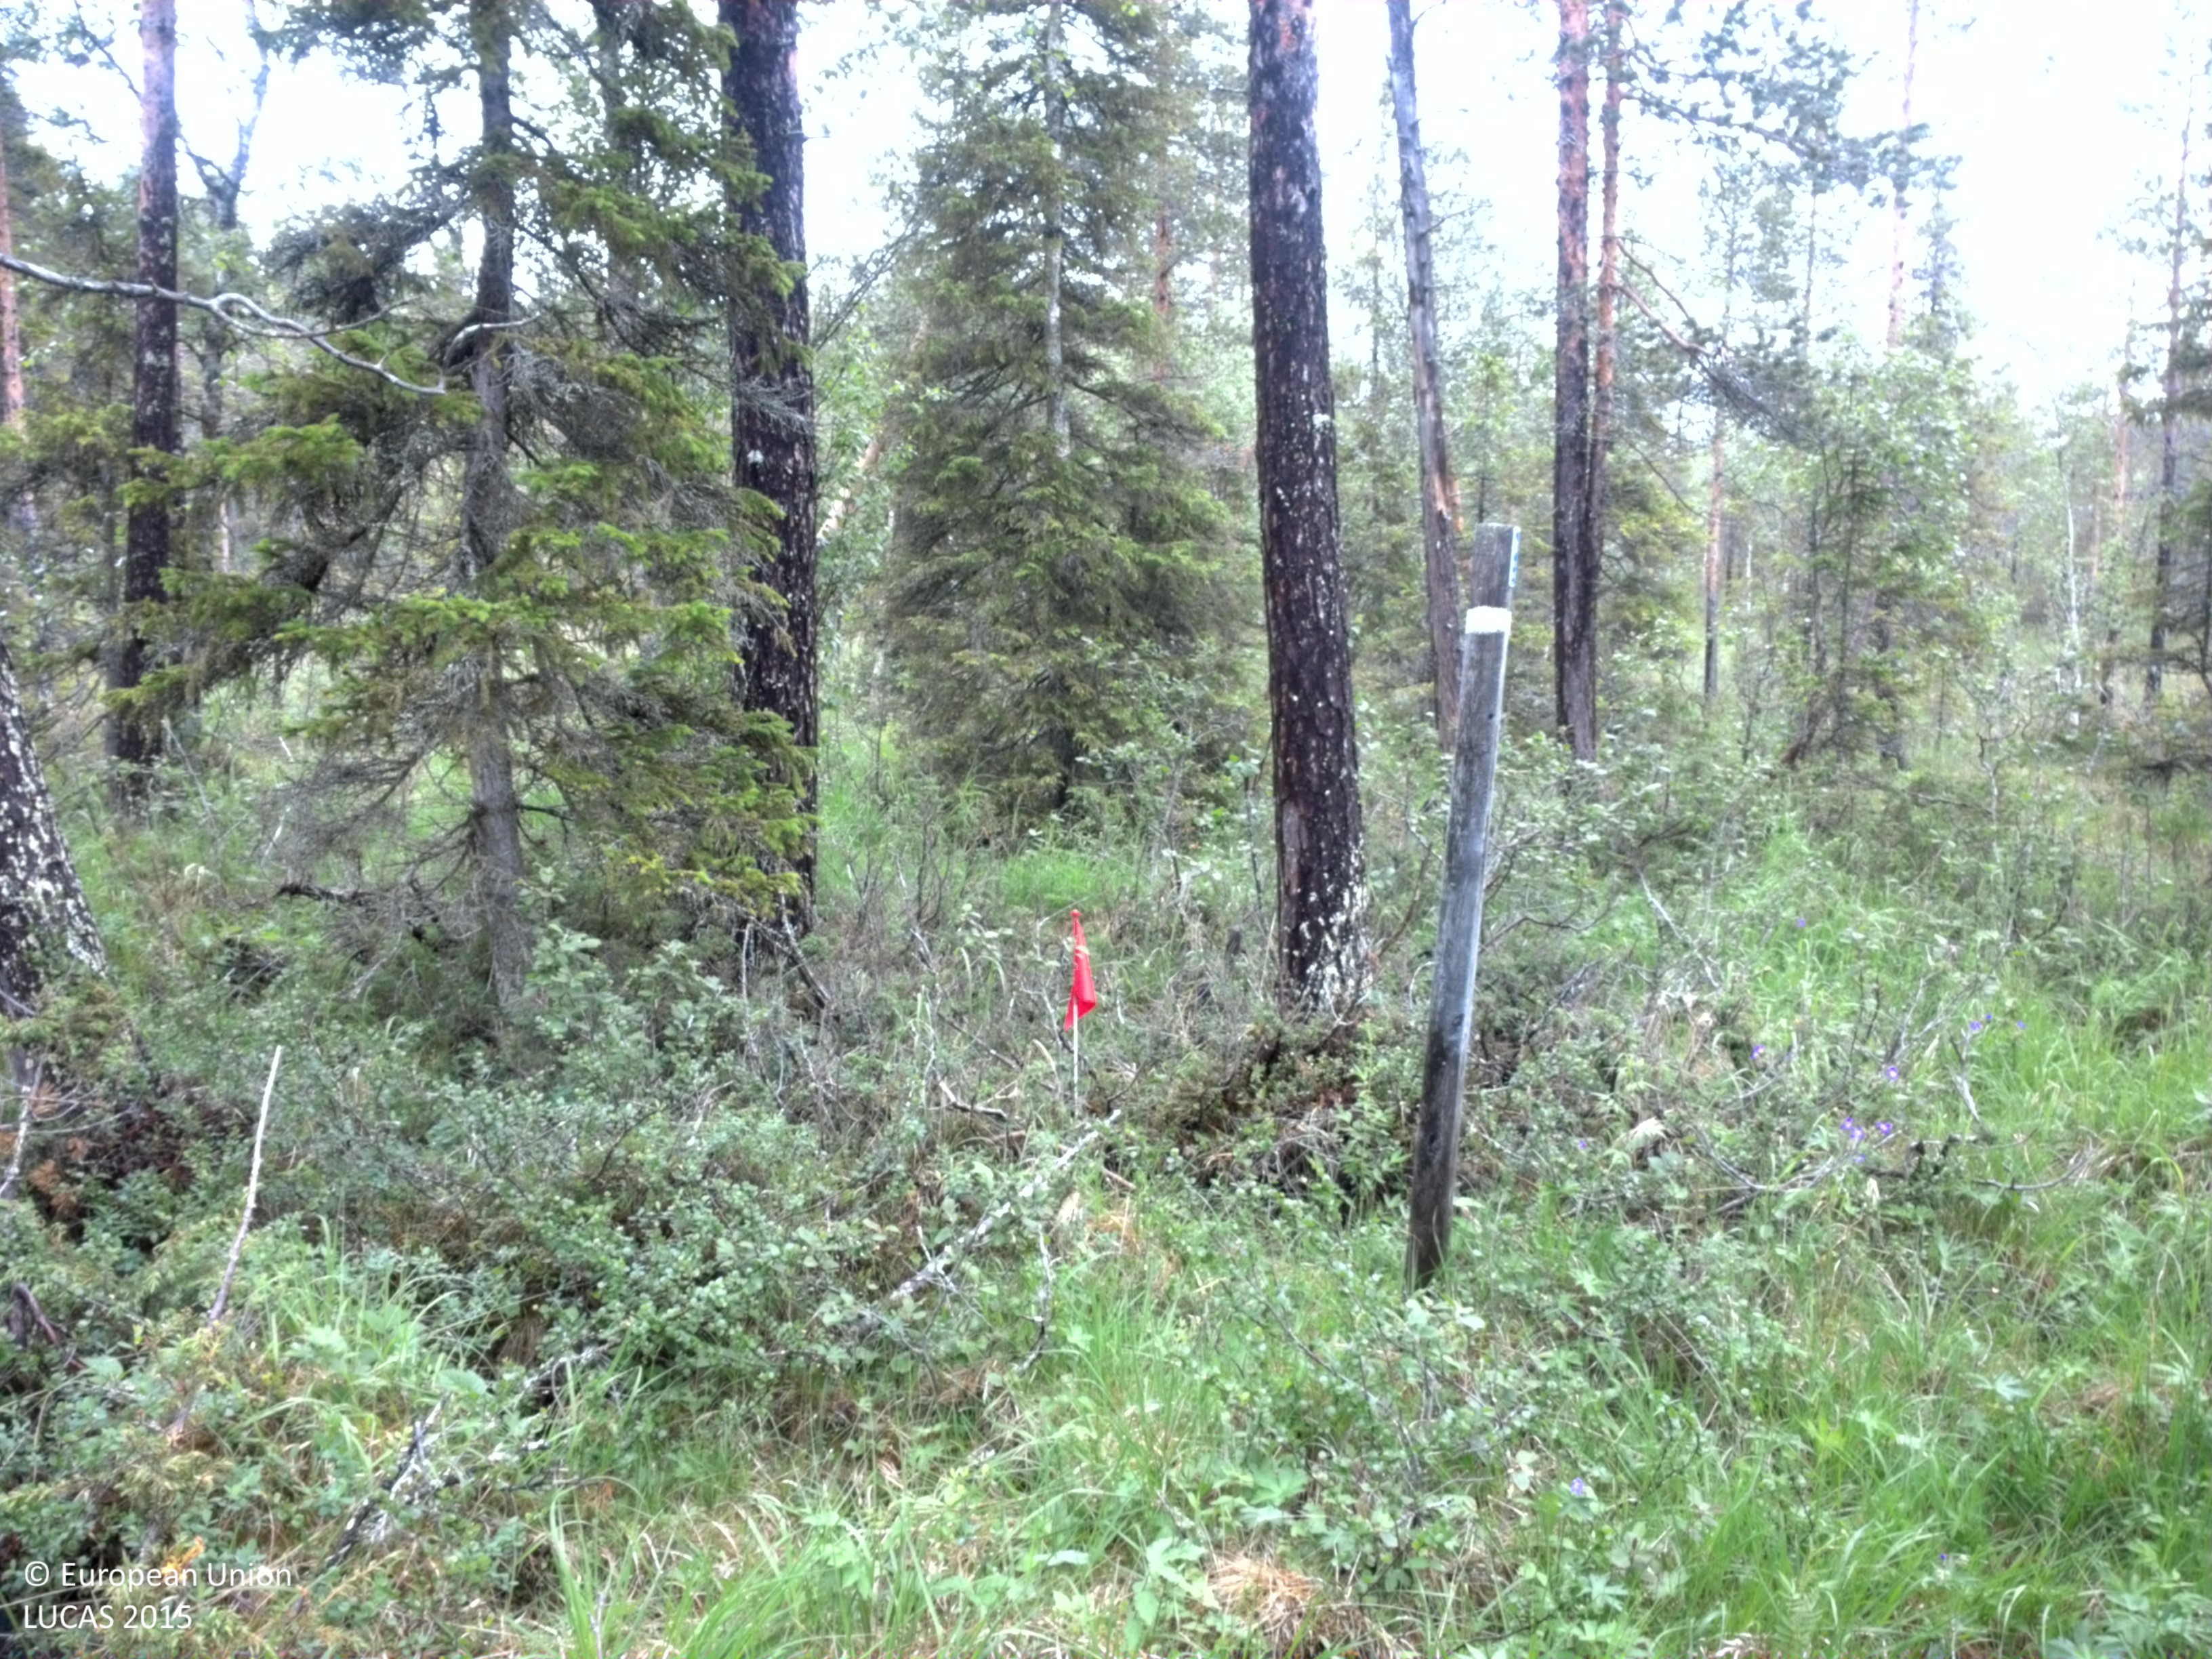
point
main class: Woodland
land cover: Pine dominated mixed woodland
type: boreal forest
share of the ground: 50 - 75 %
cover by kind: coniferous forest trees 45 %, shrubs 20 %, herbaceous plants 20 %, broadleaved forest trees 15 %
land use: Amenities, museums, leisure
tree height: > 5 m
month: July
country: SE
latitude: 64.6523
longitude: 18.3199
